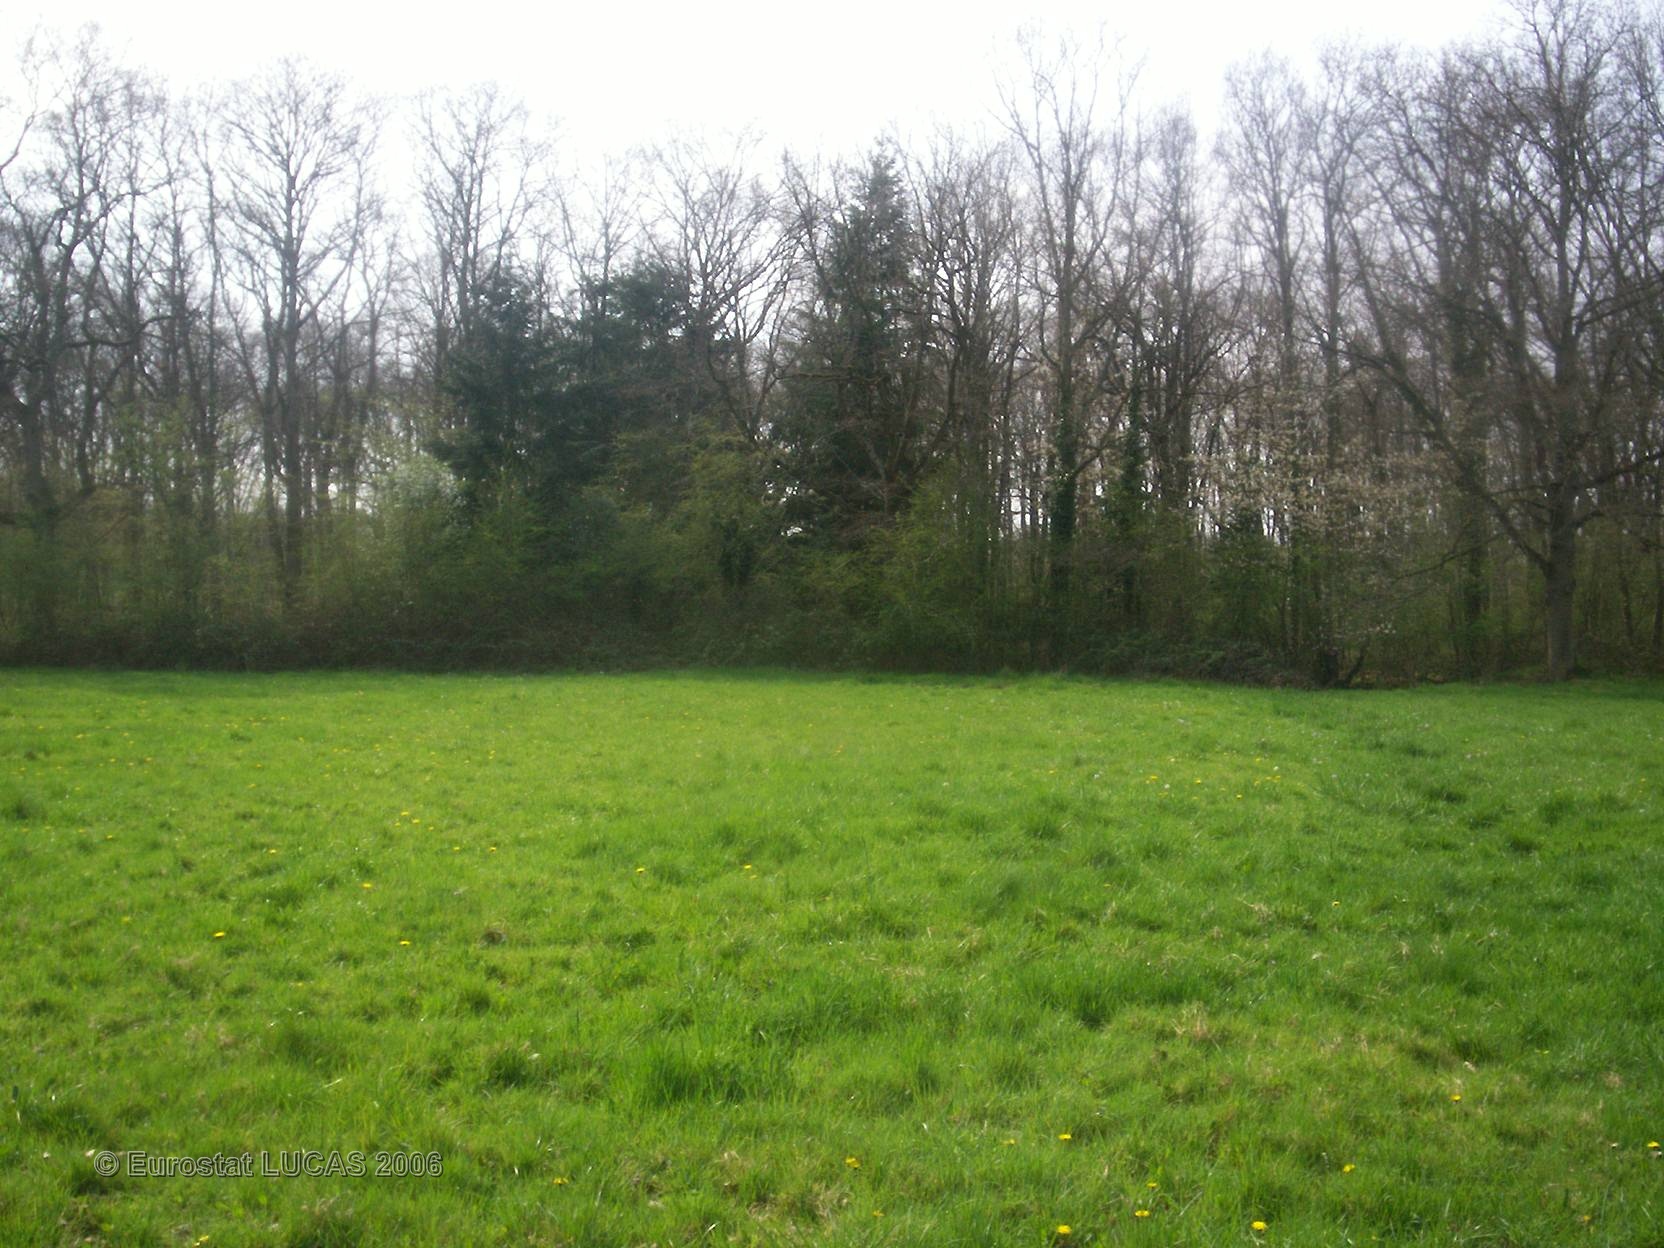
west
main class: Grassland
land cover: Grassland without tree/shrub cover
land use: Agriculture (excluding fallow land and kitchen gardens)
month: April
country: FR
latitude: 49.1003
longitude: -0.0988
